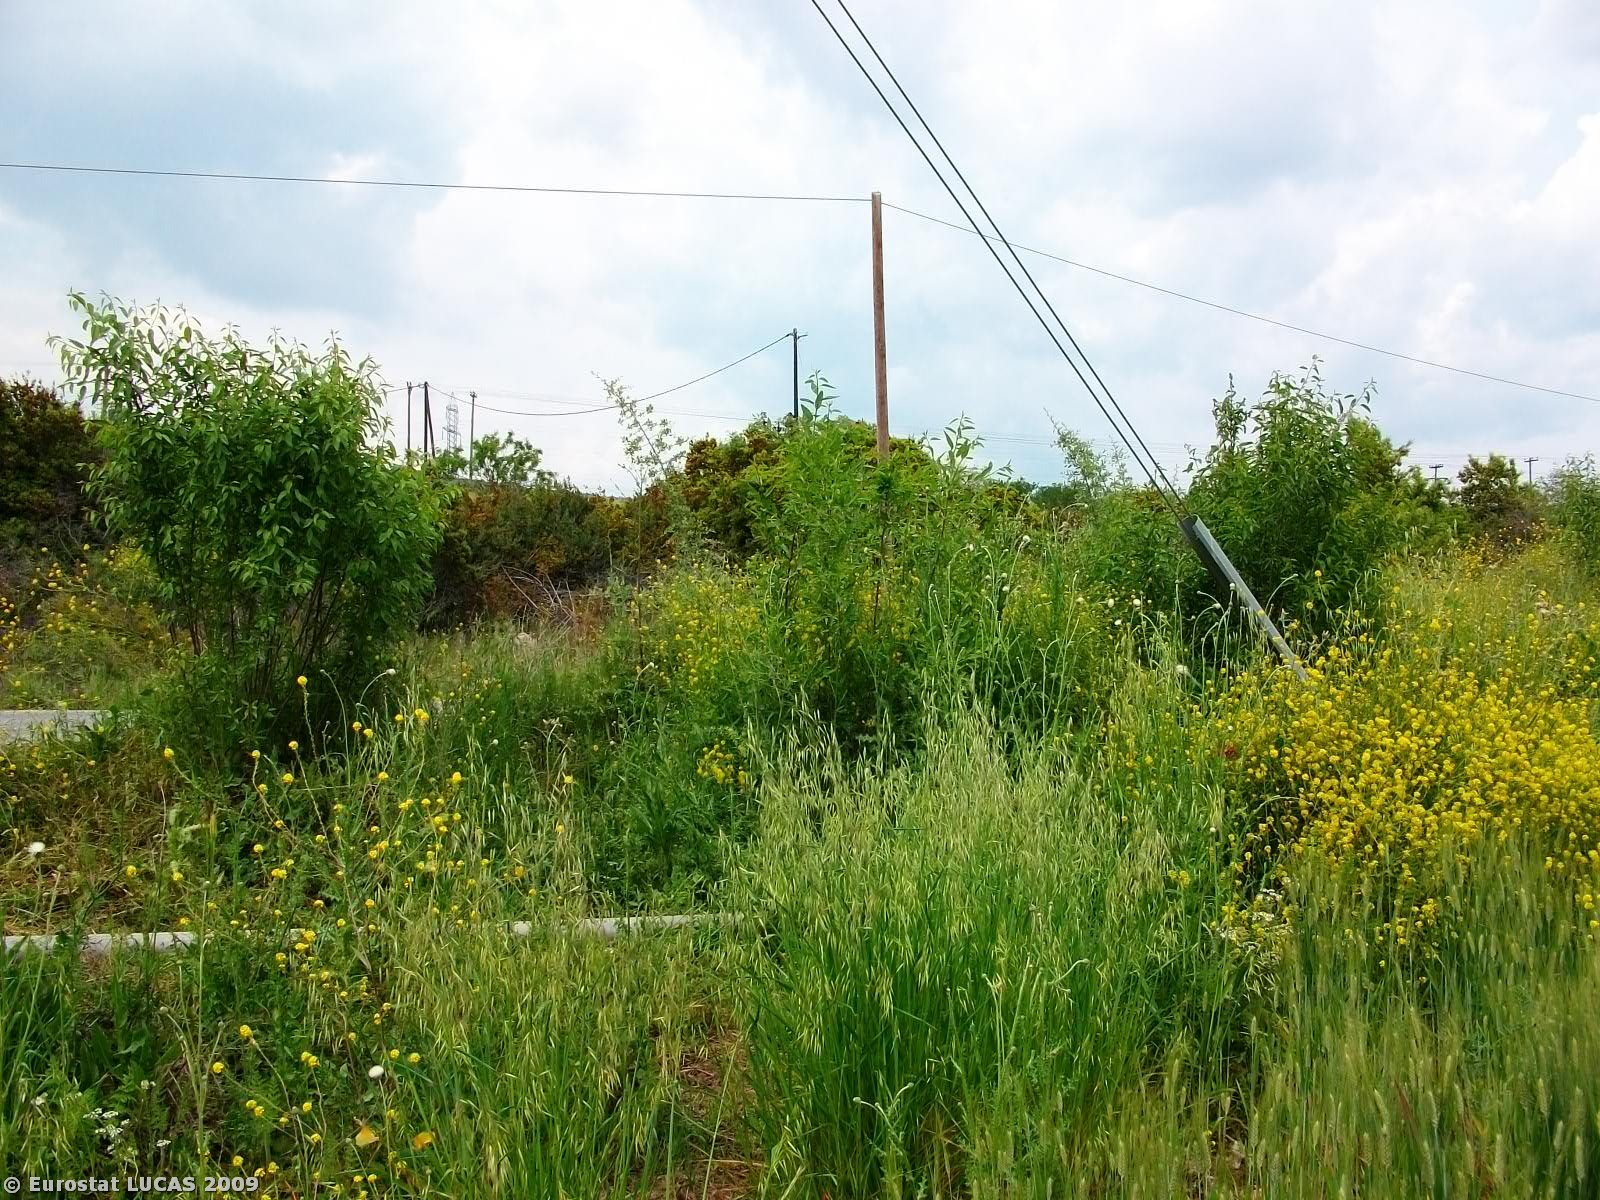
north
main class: Cropland
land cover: Durum wheat
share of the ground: > 75 %
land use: Agriculture (excluding fallow land and kitchen gardens)
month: May
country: GR
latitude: 39.3829
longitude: 22.8424
